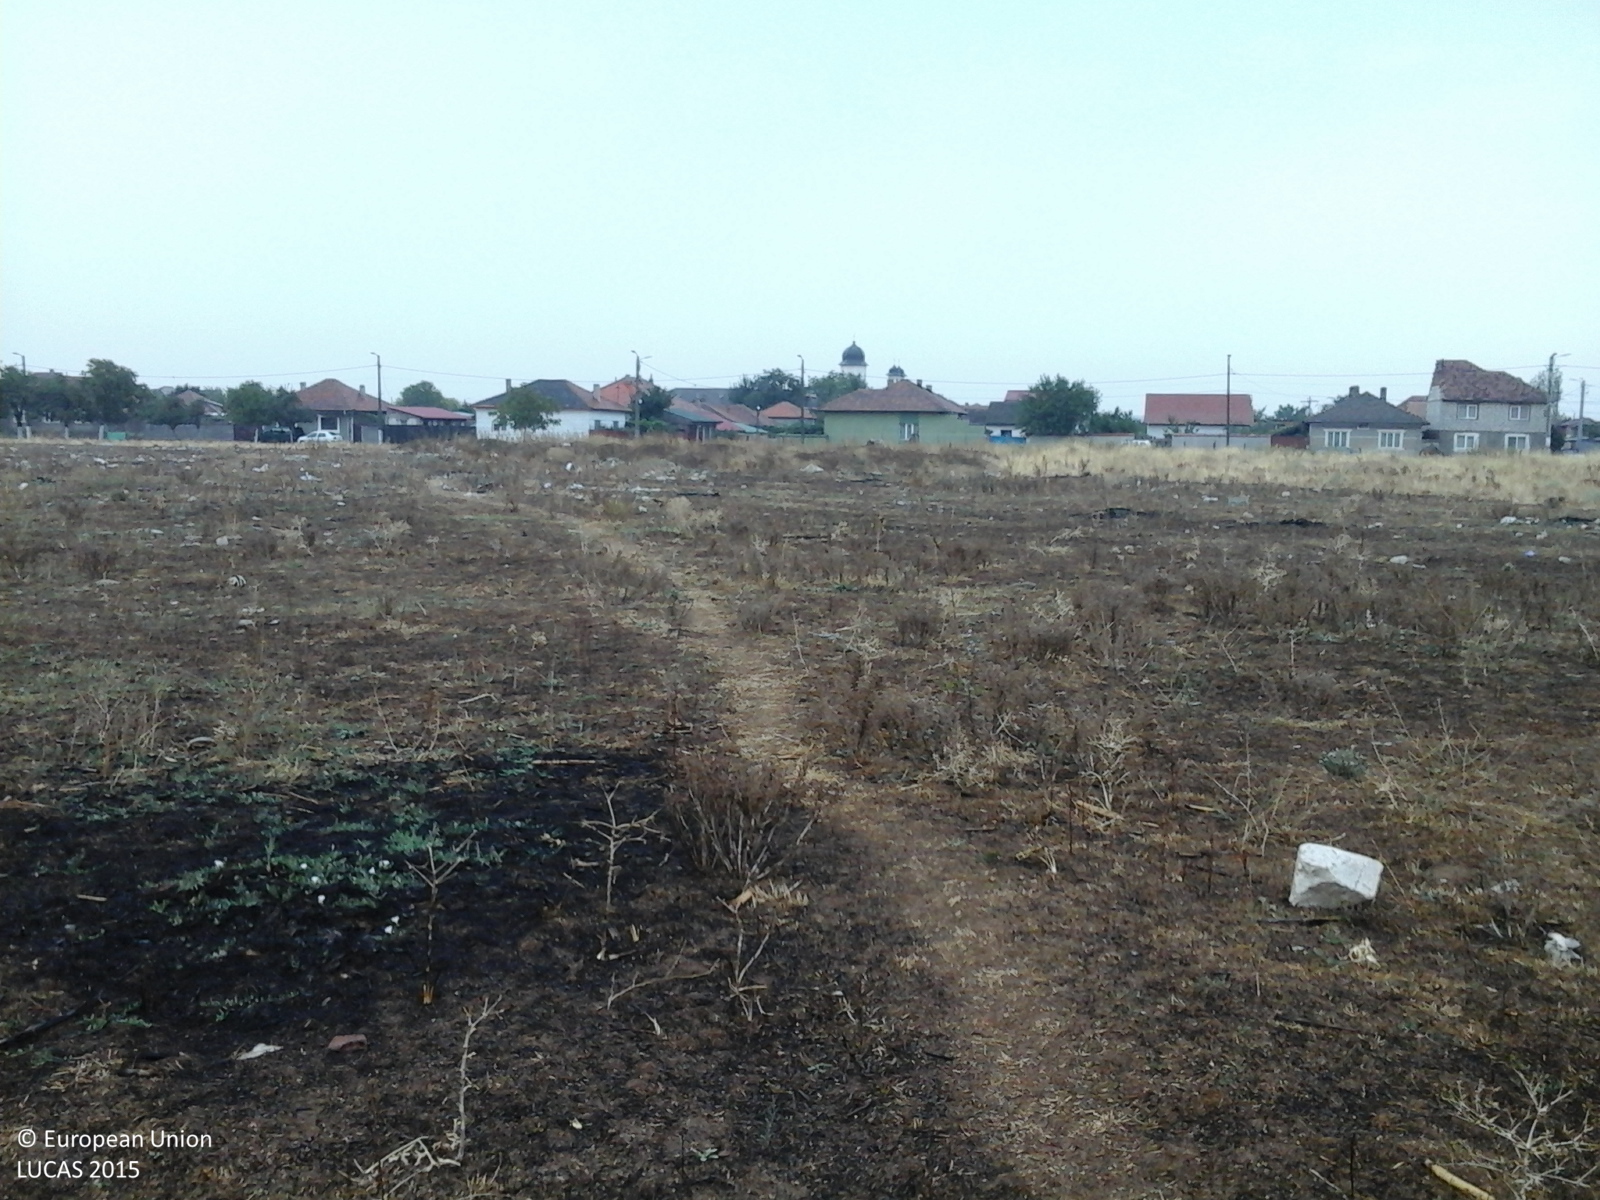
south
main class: Grassland
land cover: Spontaneously vegetated surfaces
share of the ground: 25 - 50 %
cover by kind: herbaceous plants 100 %
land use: Fallow land
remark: Burnt area
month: August
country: RO
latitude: 44.6356
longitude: 22.6093
